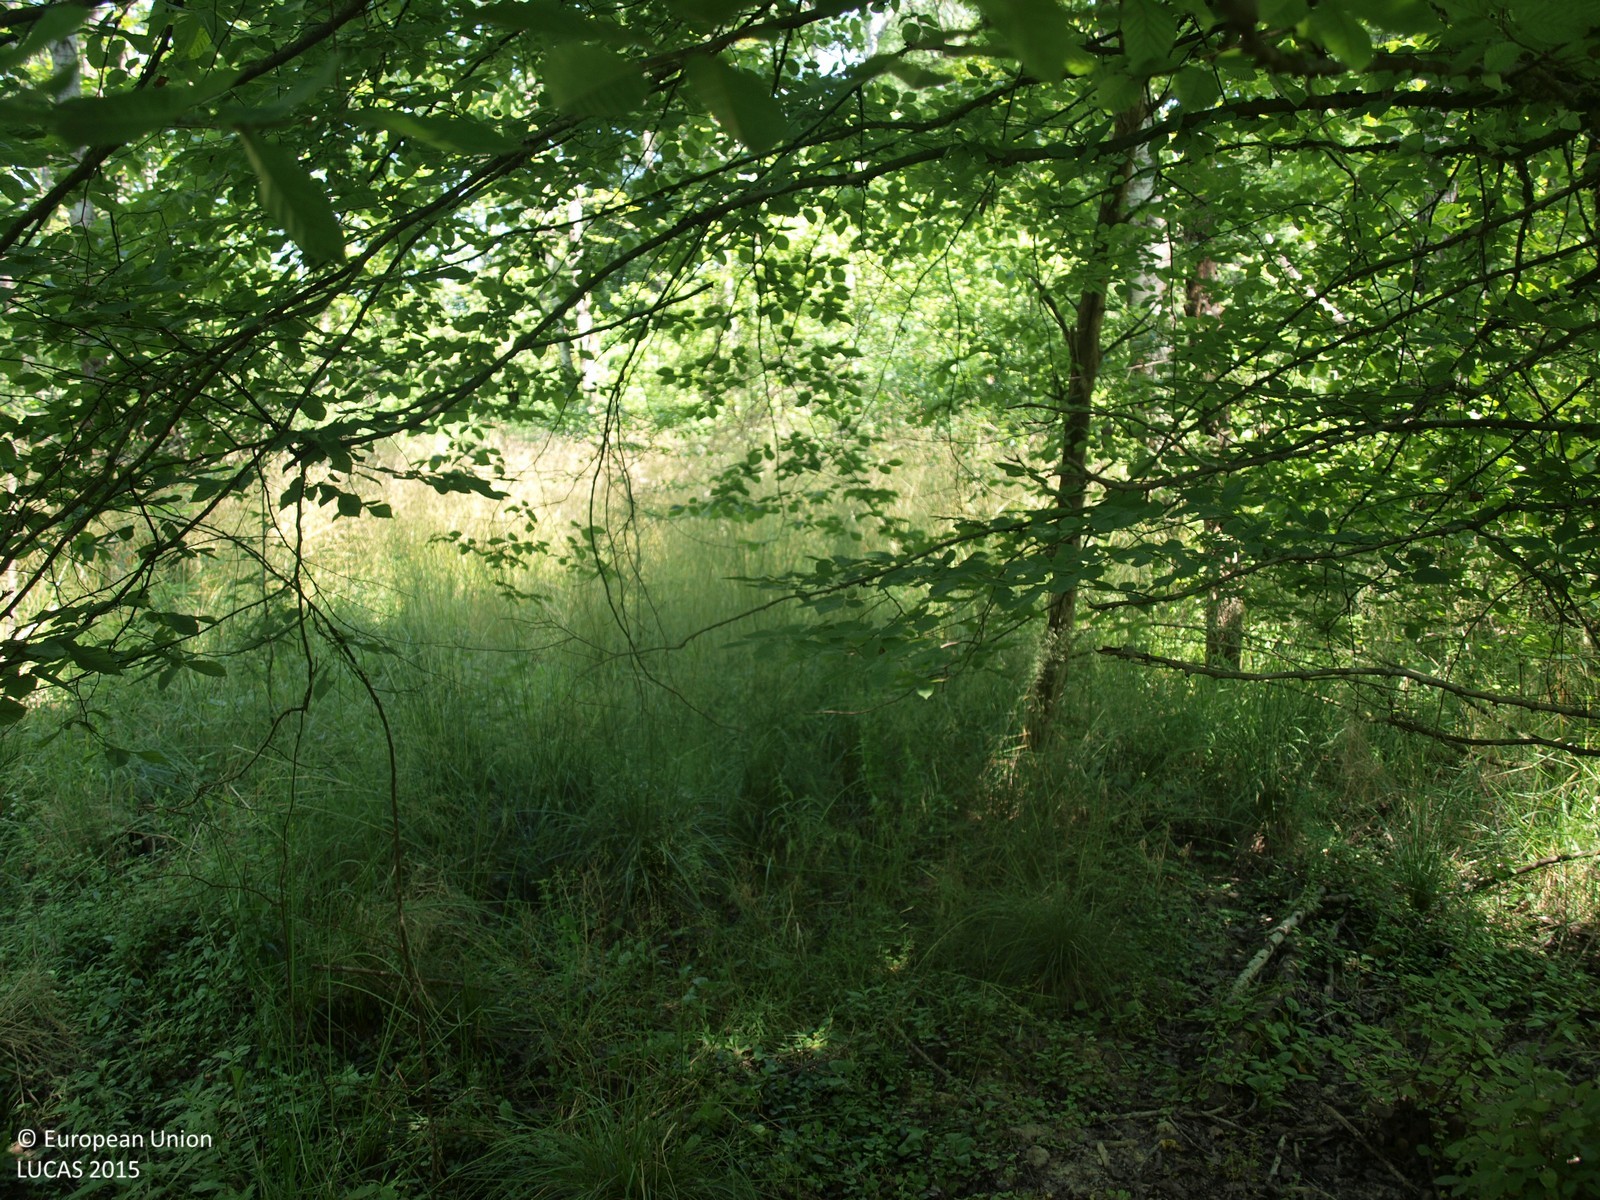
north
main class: Woodland
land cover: Broadleaved woodland
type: floodplain forest
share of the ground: > 75 %
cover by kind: broadleaved forest trees 100 %
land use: Forestry
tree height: > 5 m
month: July
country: HR
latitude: 45.6405
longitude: 15.6804
